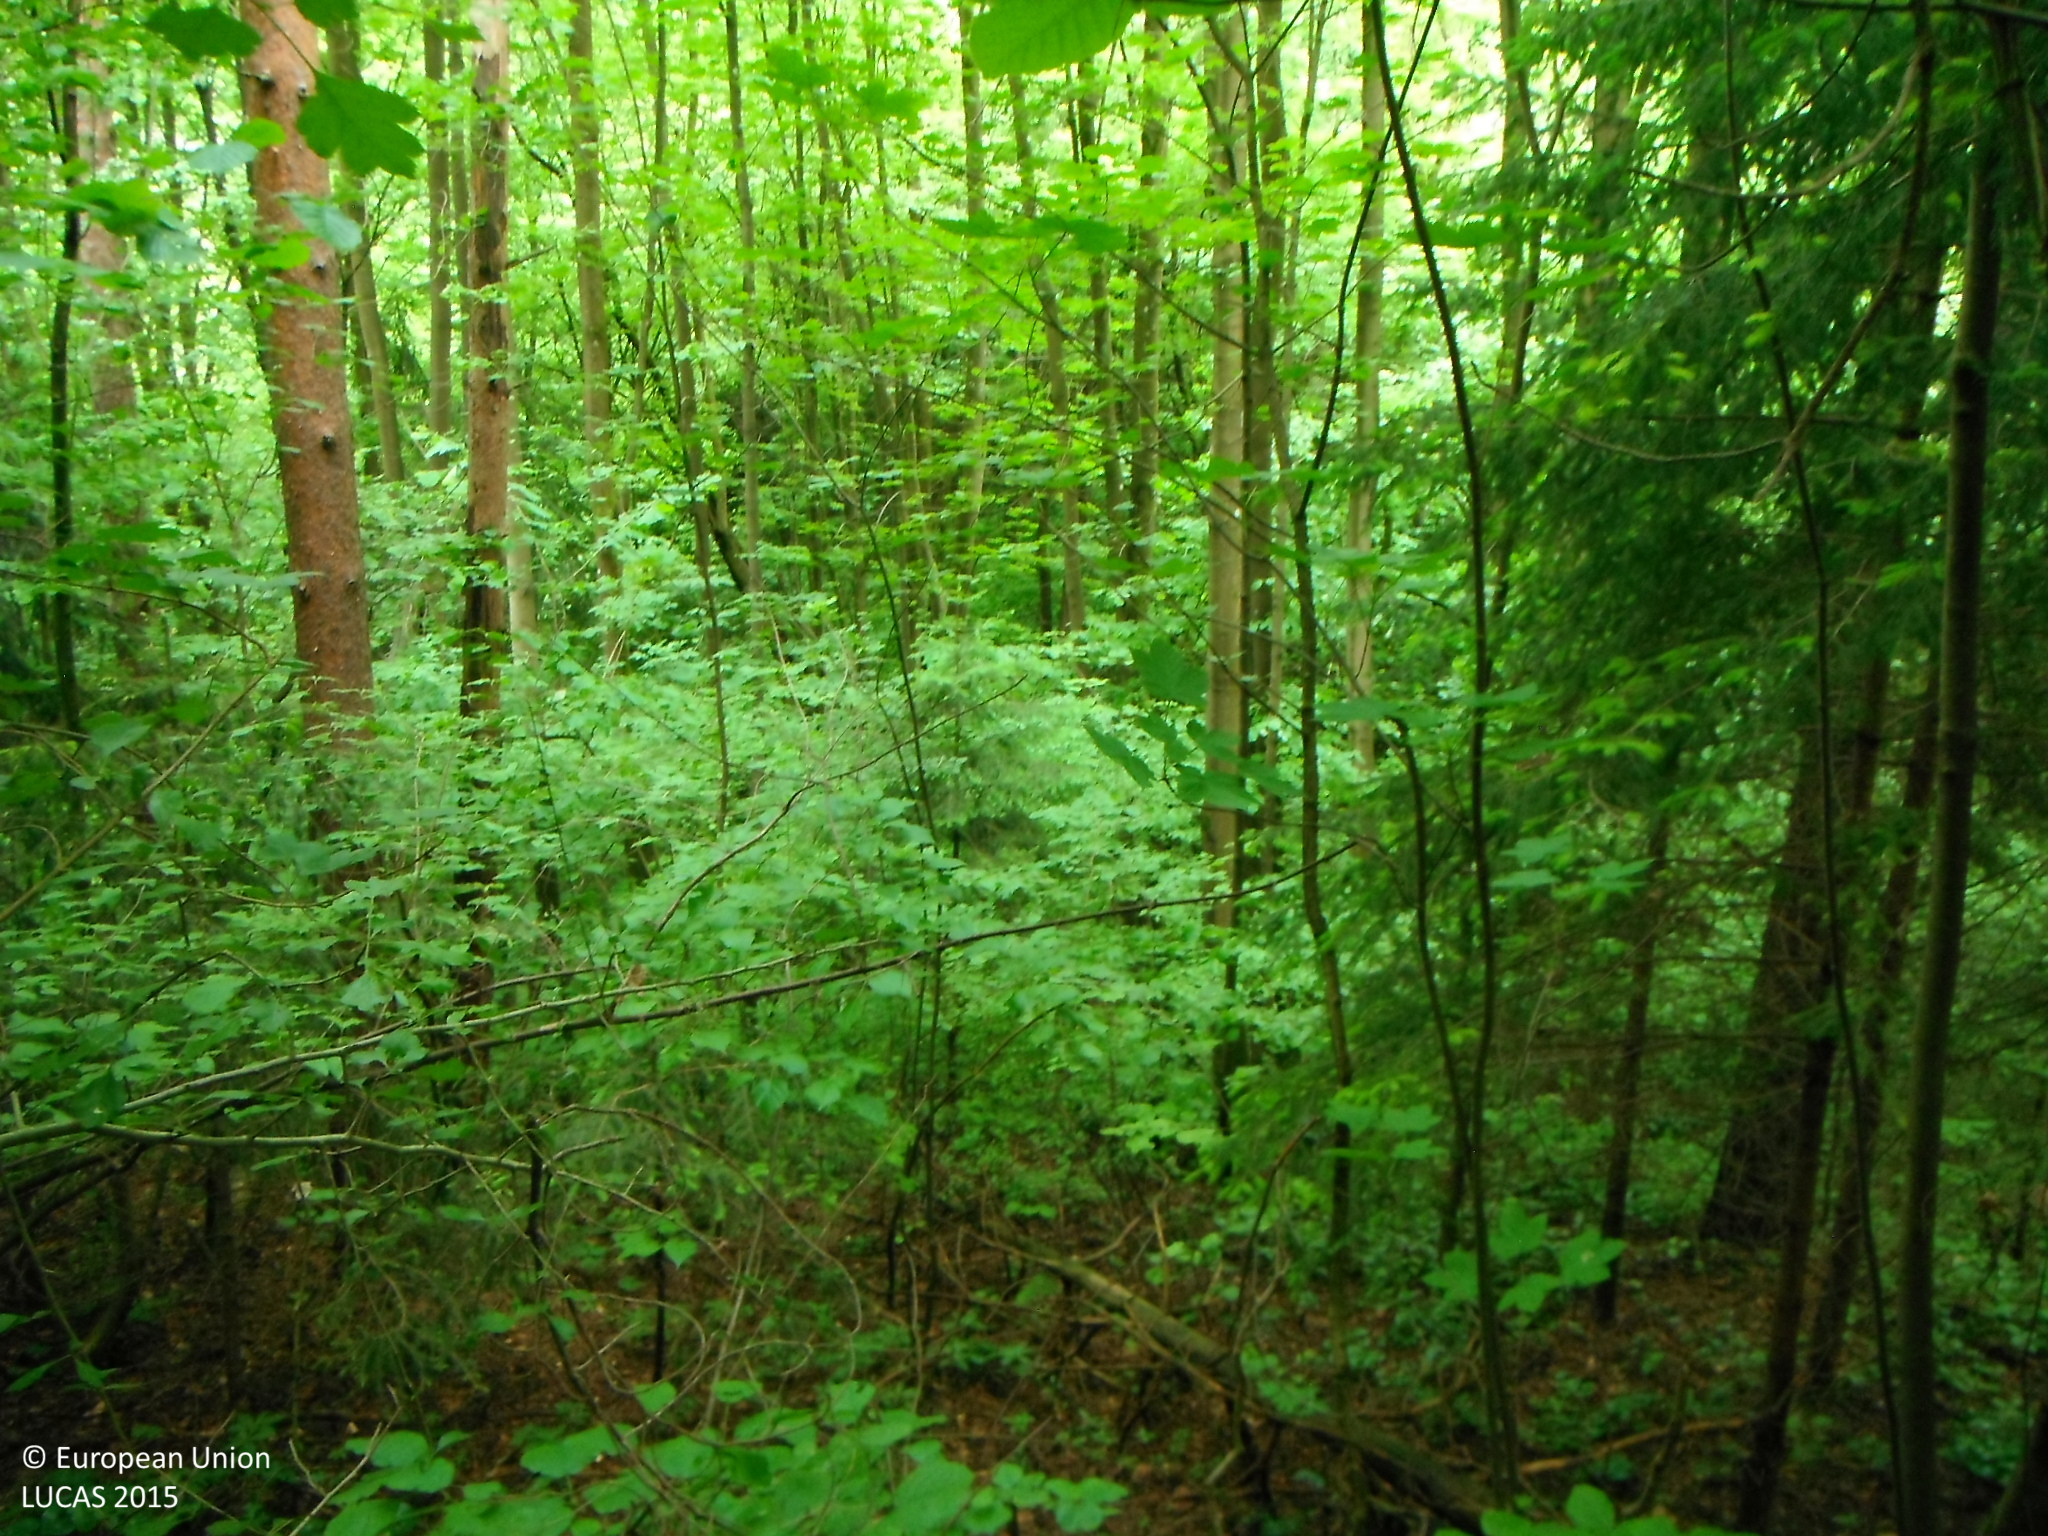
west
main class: Woodland
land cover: Spruce dominated mixed woodland
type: hemiboreal forest and nemoral coniferous forest and mixed broadleaved-coniferous forest
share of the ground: > 75 %
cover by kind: coniferous forest trees 70 %, broadleaved forest trees 30 %
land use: Semi-natural and natural areas not in use
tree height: > 5 m
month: May
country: SK
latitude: 48.7657
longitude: 19.1514
